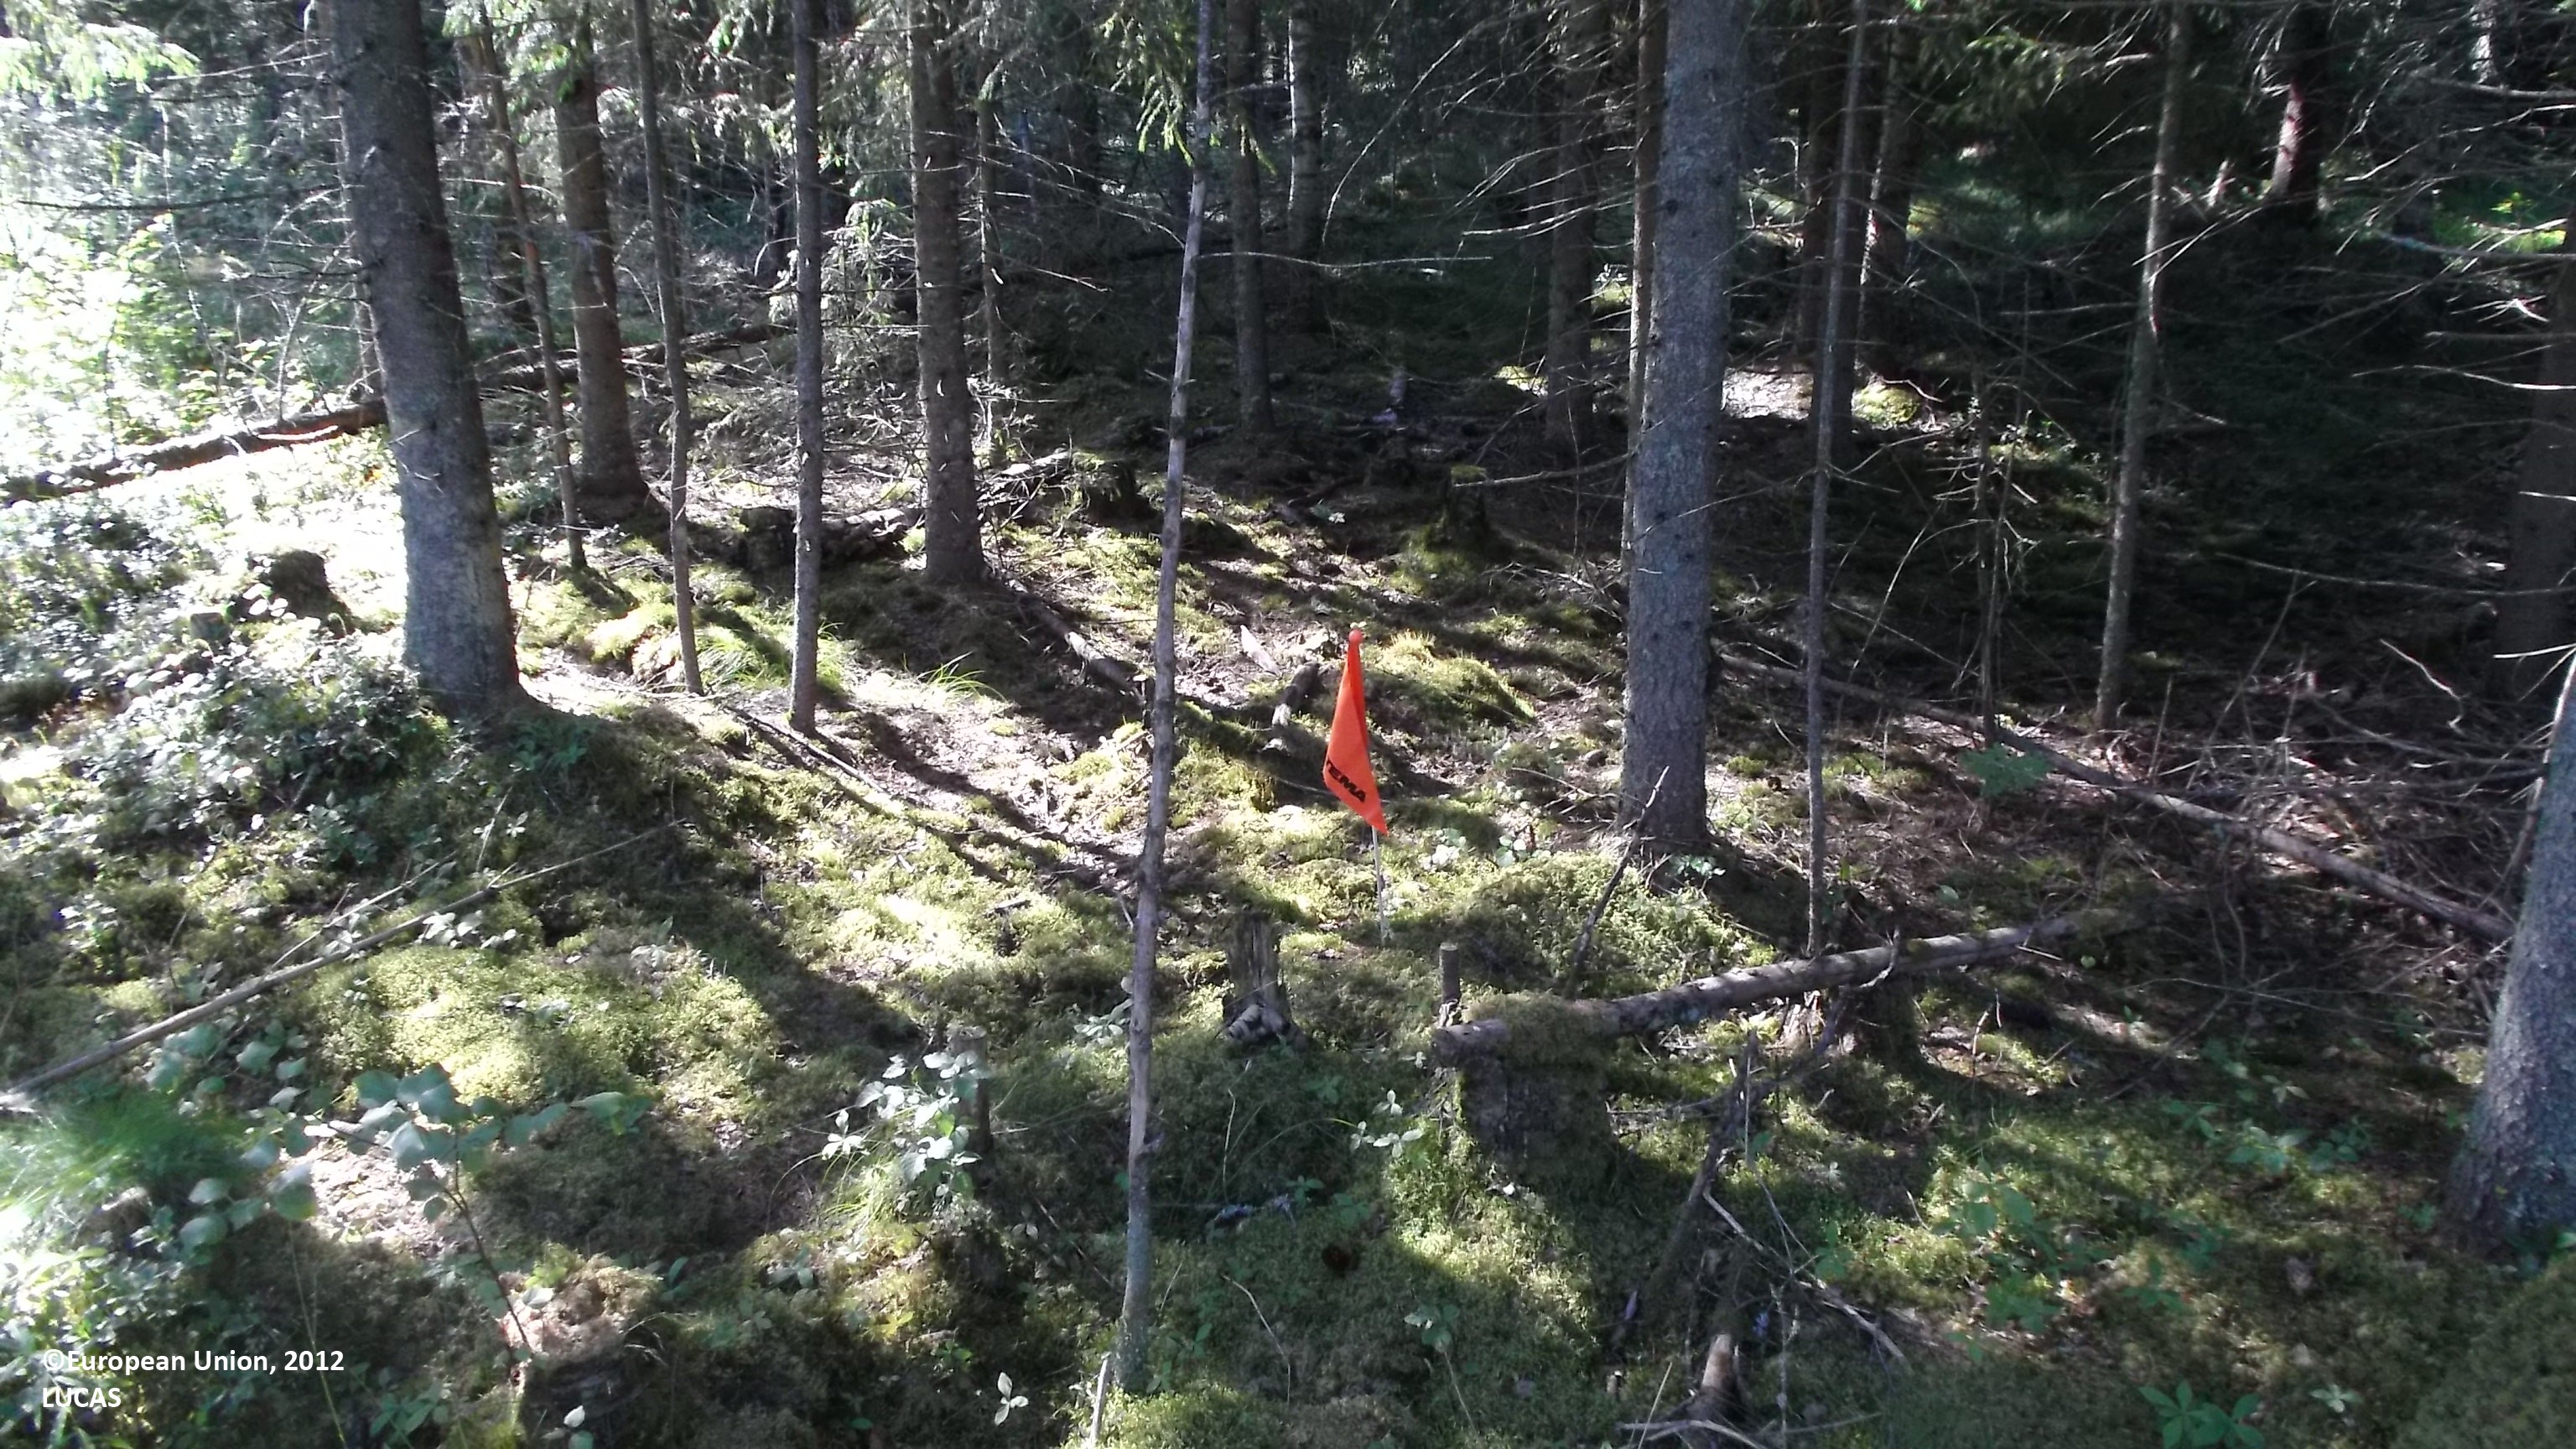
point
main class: Woodland
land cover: Spruce dominated coniferous woodland
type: boreal forest
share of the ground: > 75 %
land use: Forestry
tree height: > 5 m
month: July
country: FI
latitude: 63.8608
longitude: 23.2170
